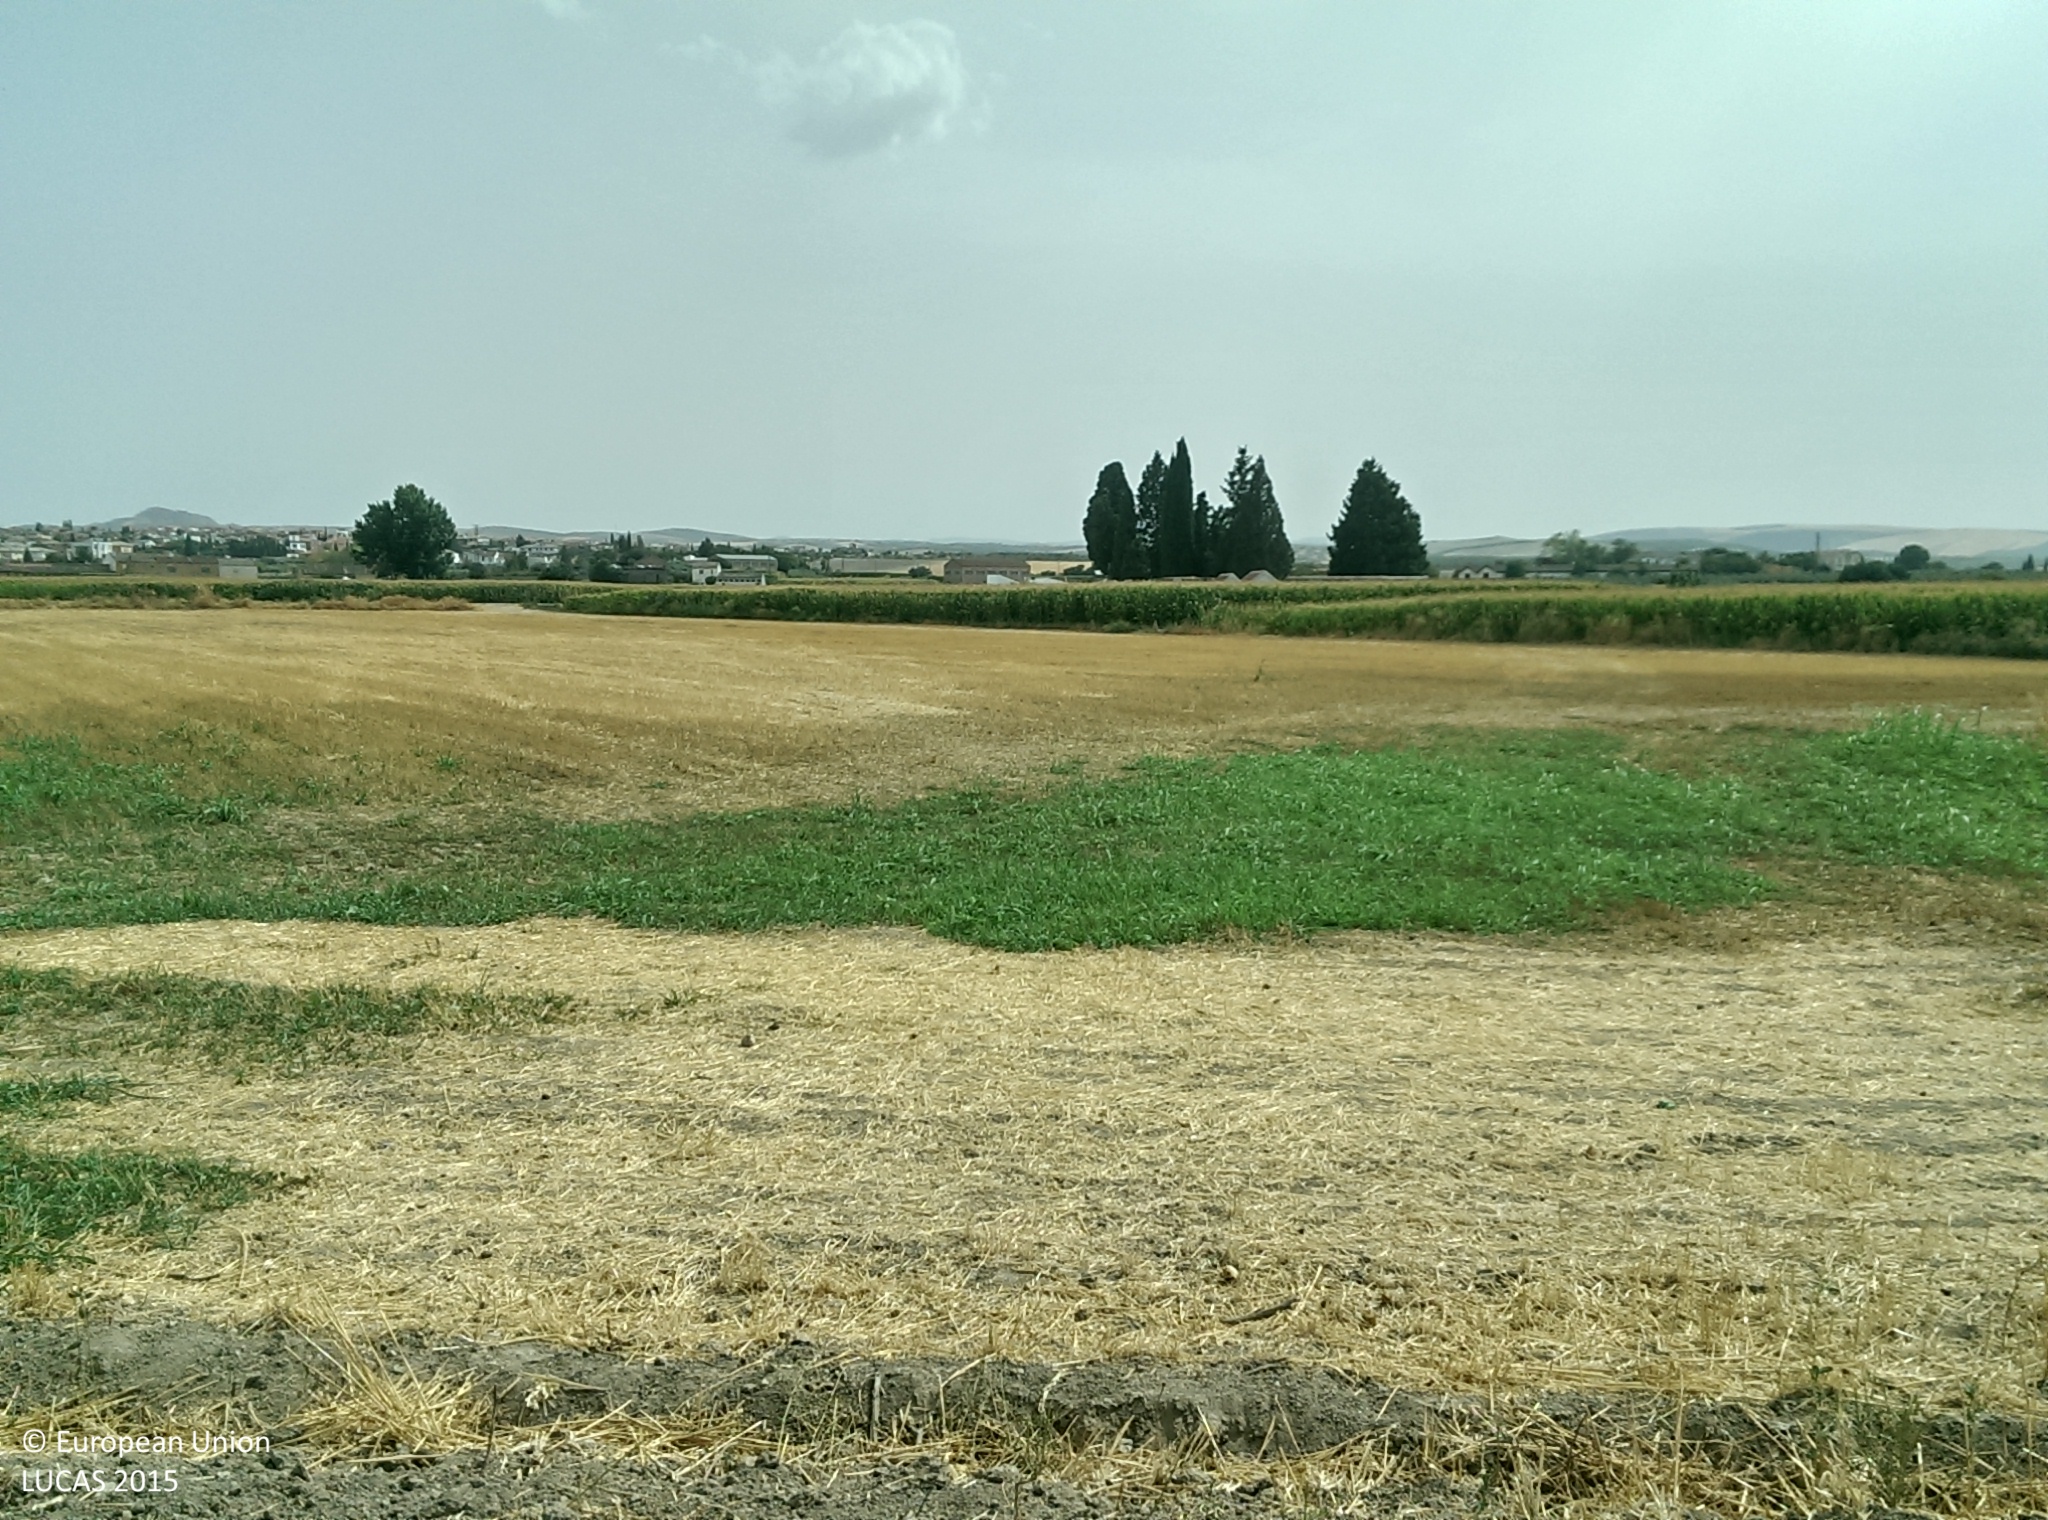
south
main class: Cropland
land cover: Common wheat
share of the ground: < 10 %
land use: Agriculture (excluding fallow land and kitchen gardens)
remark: Harvested field
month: August
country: ES
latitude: 37.1738
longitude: -3.6968
